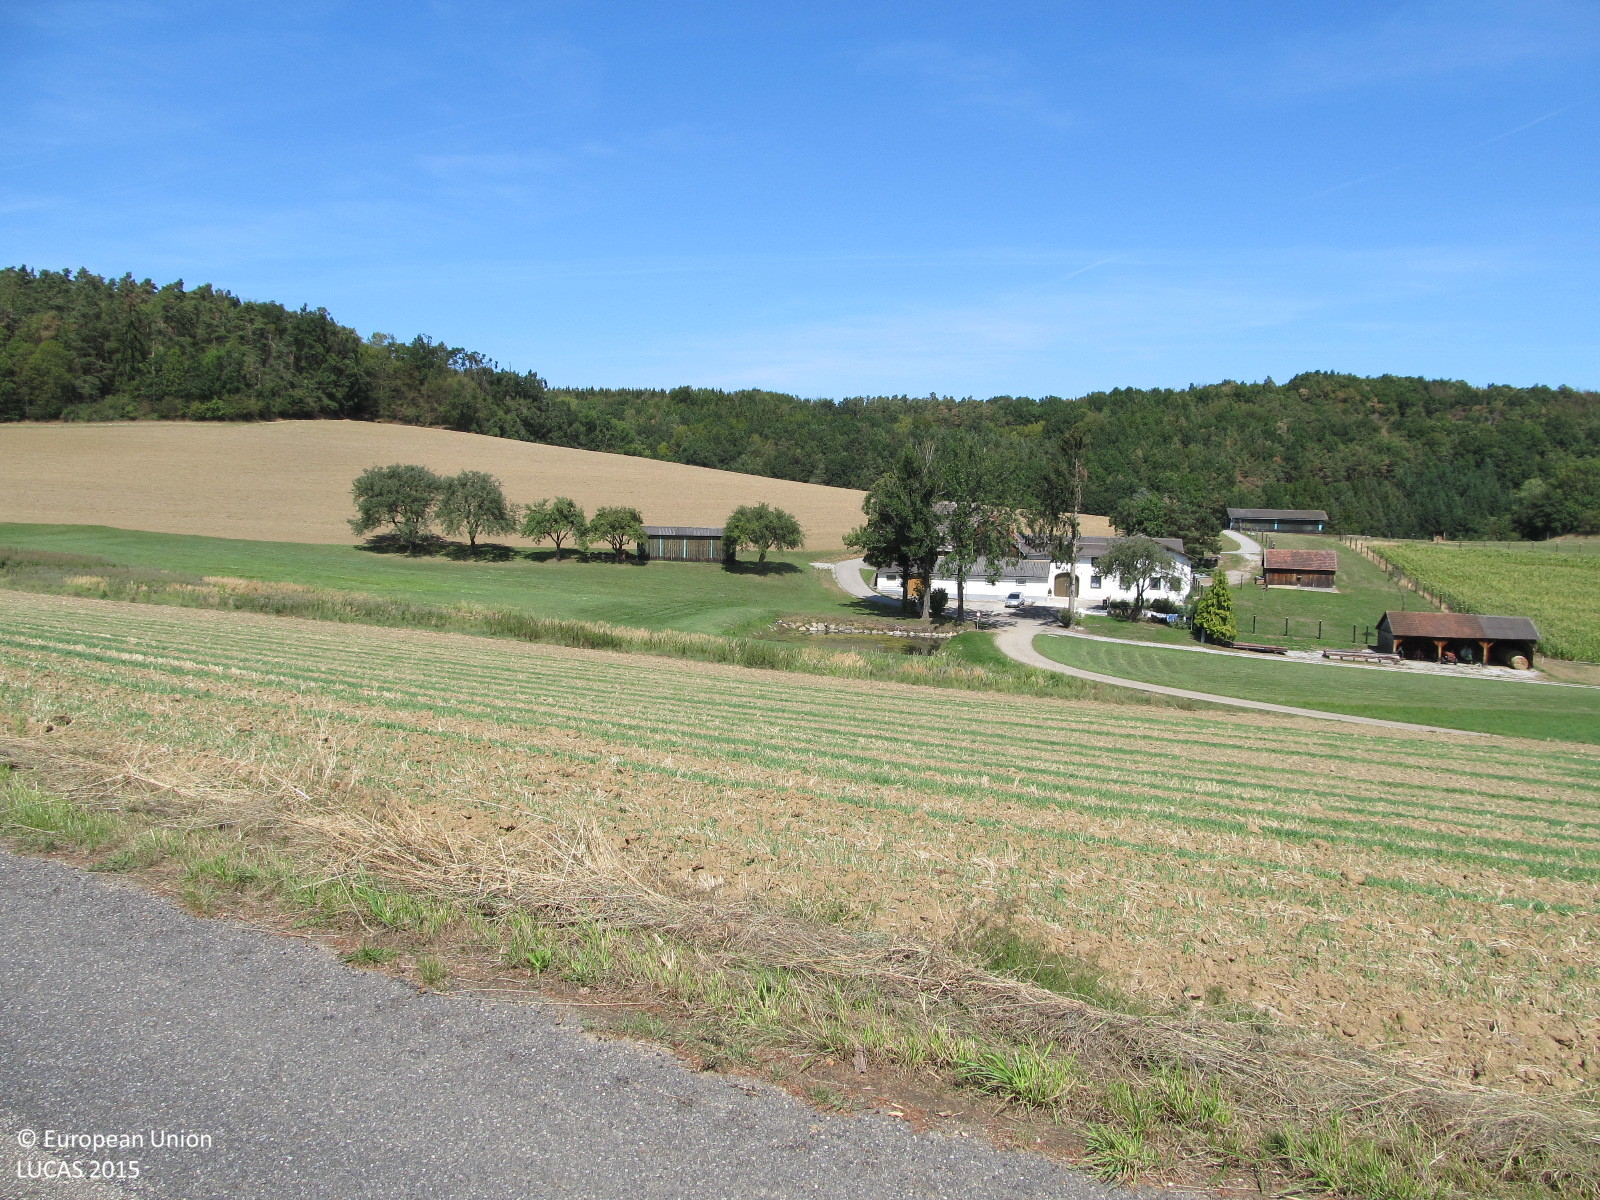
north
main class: Cropland
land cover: Maize
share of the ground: > 75 %
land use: Agriculture (excluding fallow land and kitchen gardens)
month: August
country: AT
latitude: 48.5032
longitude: 15.4571
